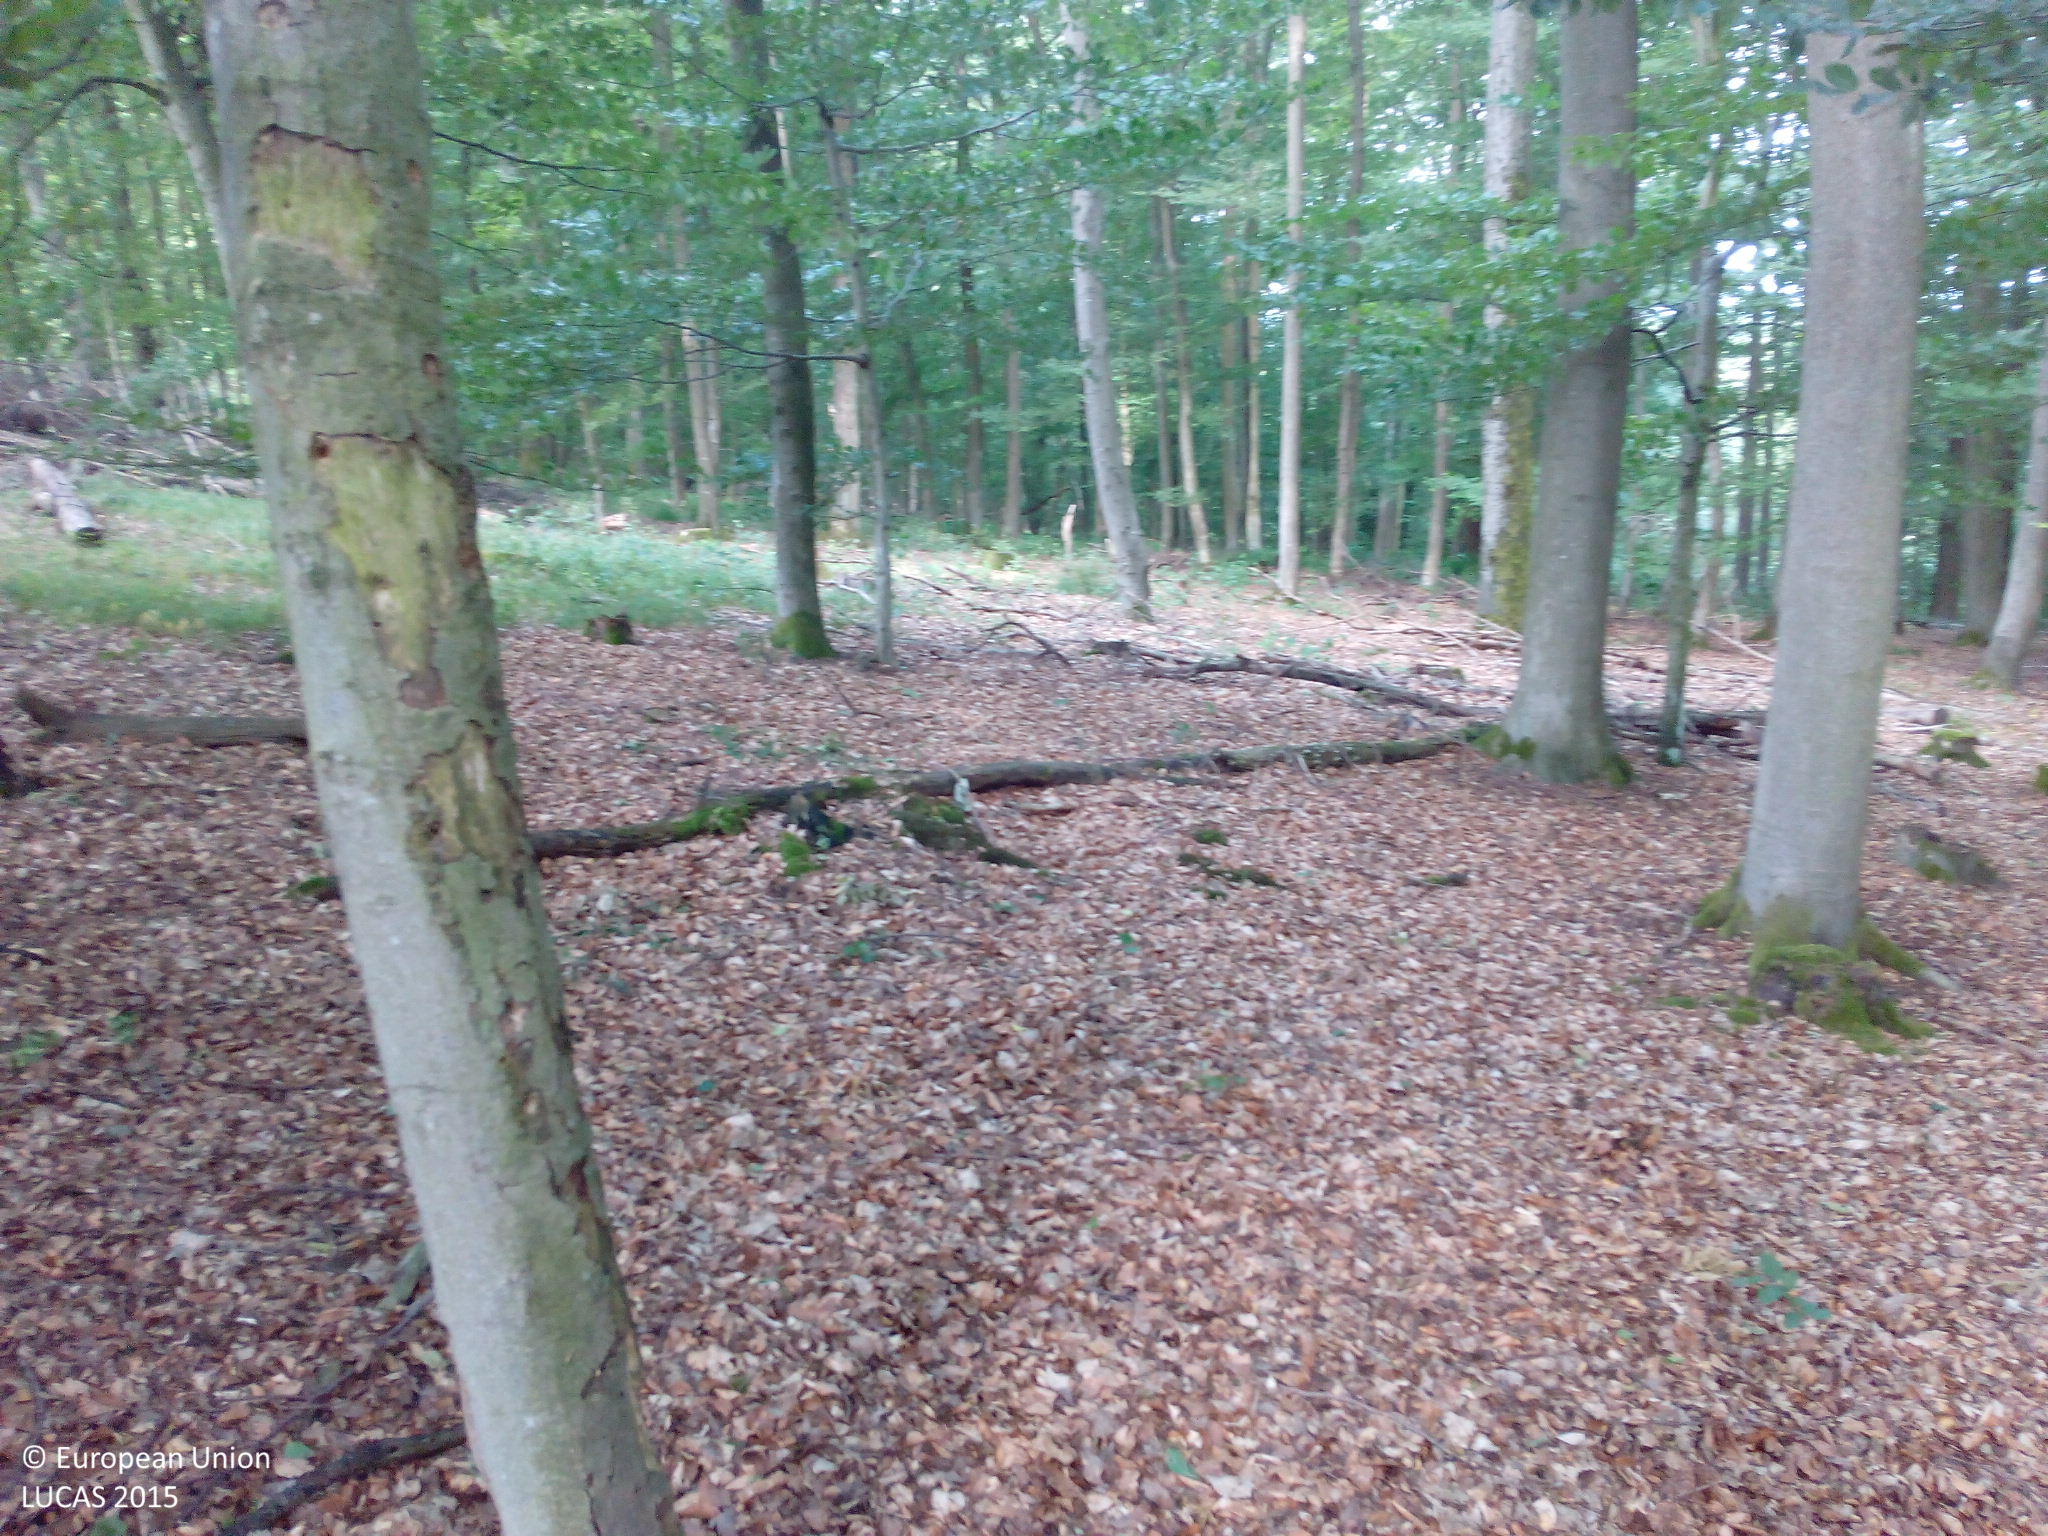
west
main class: Woodland
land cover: Broadleaved woodland
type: mesophytic deciduous forest
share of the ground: > 75 %
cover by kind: broadleaved forest trees 90 %, unconsolidated bare surface 10 %
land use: Forestry
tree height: > 5 m
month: July
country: DE
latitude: 49.8231
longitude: 10.5697
